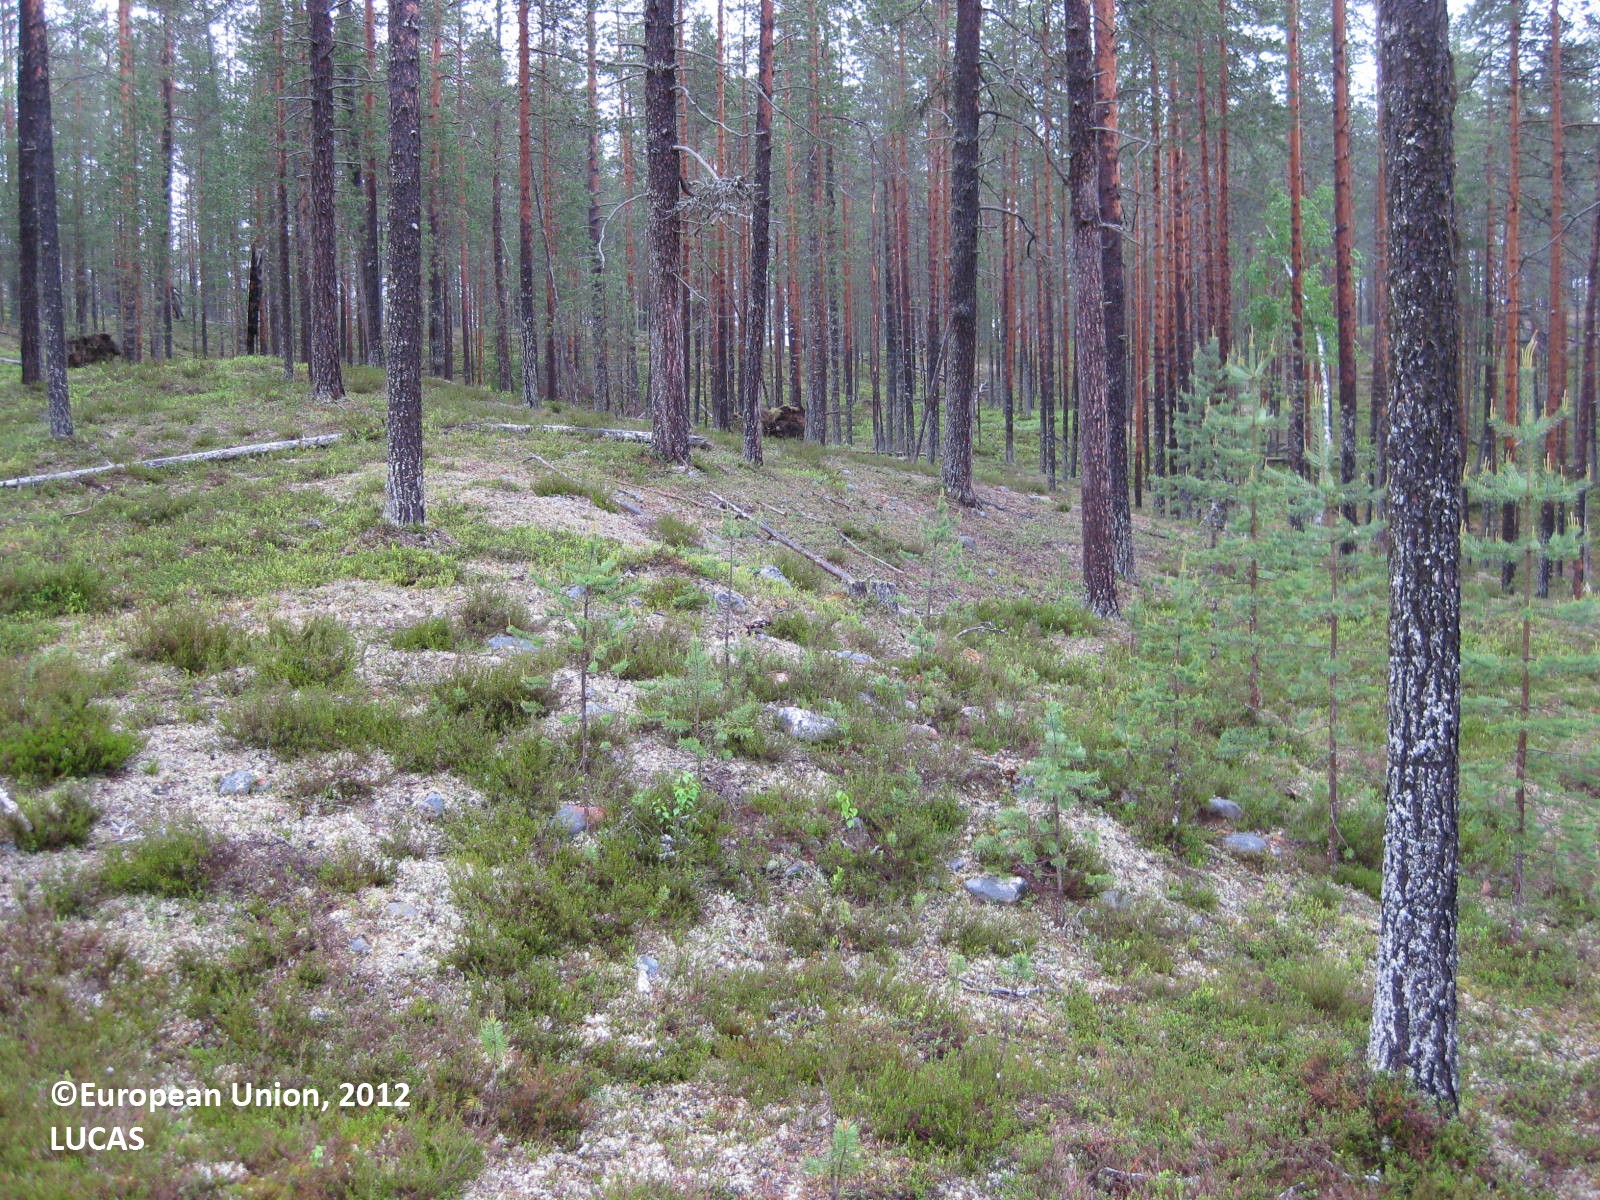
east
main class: Woodland
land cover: Pine dominated coniferous woodland
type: boreal forest
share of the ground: 50 - 75 %
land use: Forestry
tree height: > 5 m
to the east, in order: Pine dominated coniferous woodland; Abandoned hedges; Ditches and canals; Abandoned hedges; Paved roads, cycling and walking lanes; Abandoned hedges; Ditches and canals; Pine dominated coniferous woodland
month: June
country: FI
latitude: 65.4356
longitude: 29.6732
